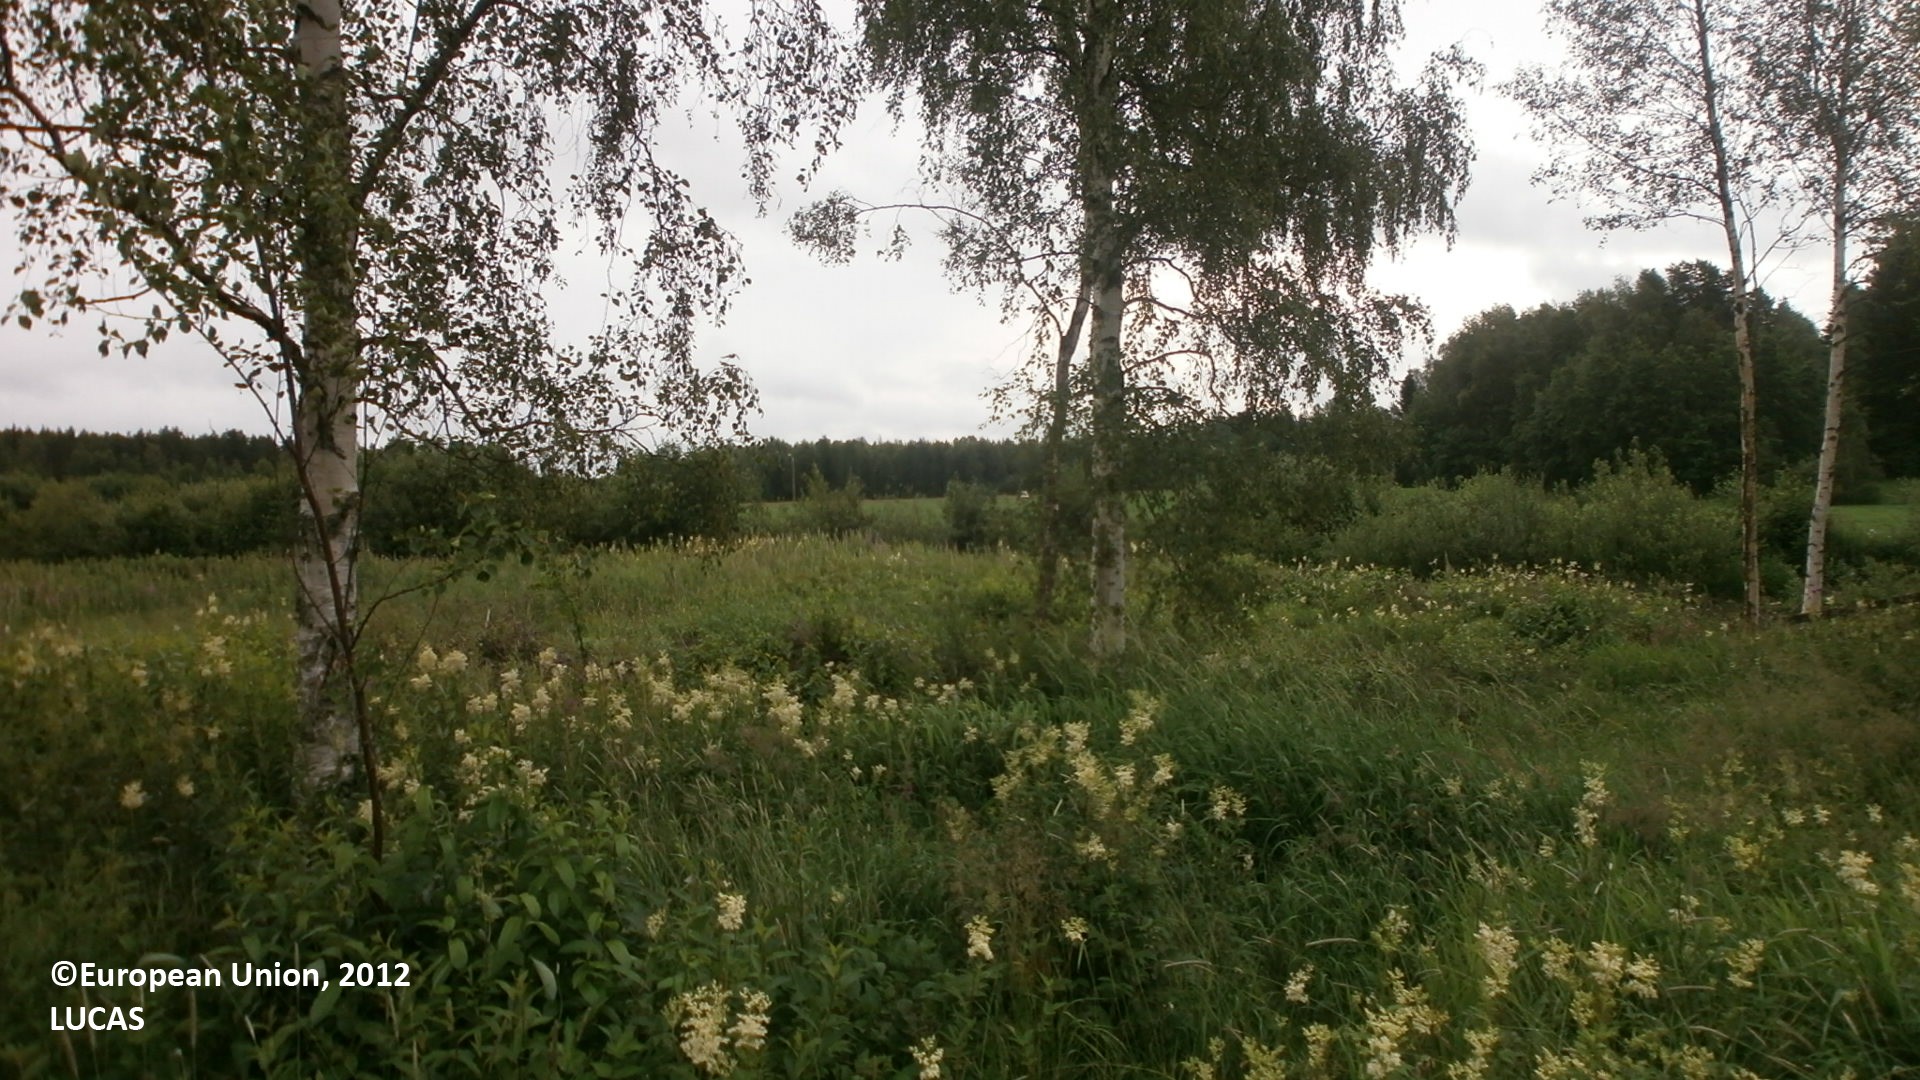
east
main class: Grassland
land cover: Grassland without tree/shrub cover
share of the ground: > 75 %
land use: Agriculture (excluding fallow land and kitchen gardens)
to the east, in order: Grassland without tree/shrub cover; Broadleaved woodland; Shruby margins; Ditches and canals; Shrubland with sparse tree cover; Barley; Shruby margins; Ditches and canals; Shruby margins; Paved roads, cycling and walking lanes; Shruby margins; Ditches and canals; Electric lines; Shruby margins; Temporary grasslands
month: July
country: FI
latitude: 64.6009
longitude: 24.4217
